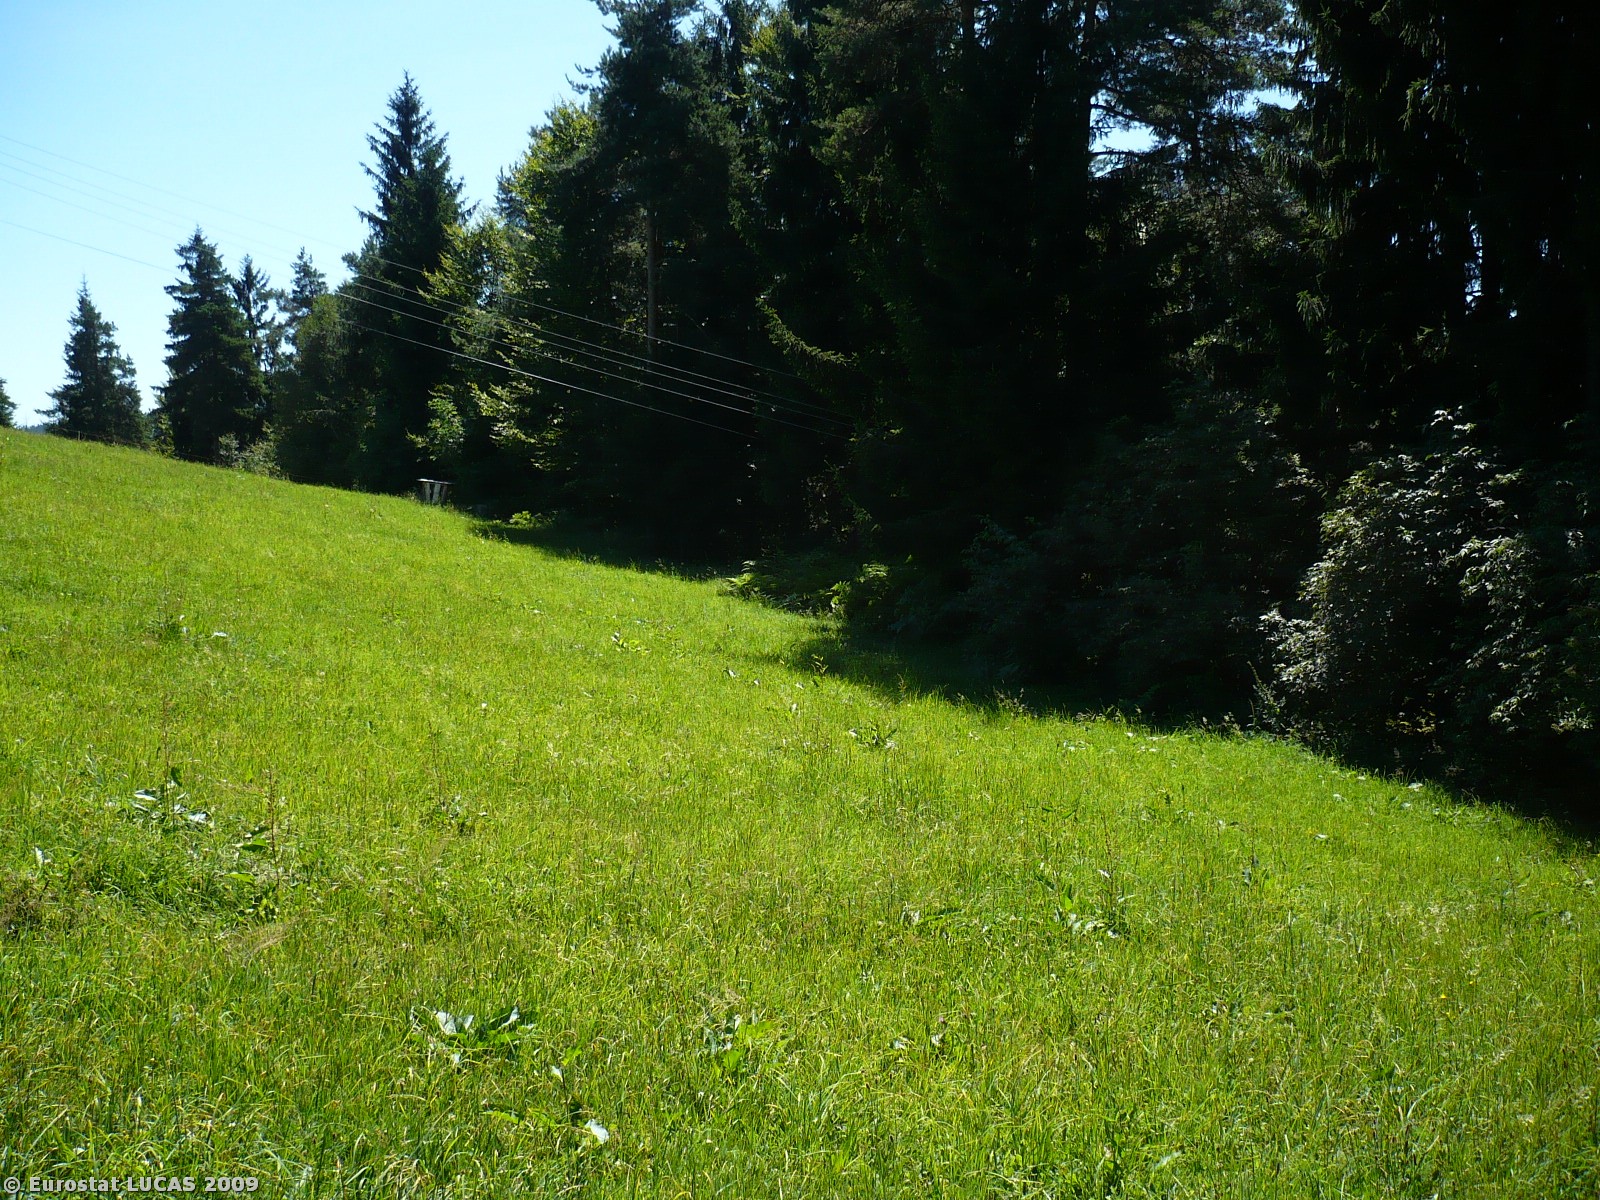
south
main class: Grassland
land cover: Grassland without tree/shrub cover
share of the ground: > 75 %
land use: Agriculture (excluding fallow land and kitchen gardens)
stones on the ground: 10 - 25 %
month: July
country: SI
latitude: 46.6508
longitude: 15.3429
